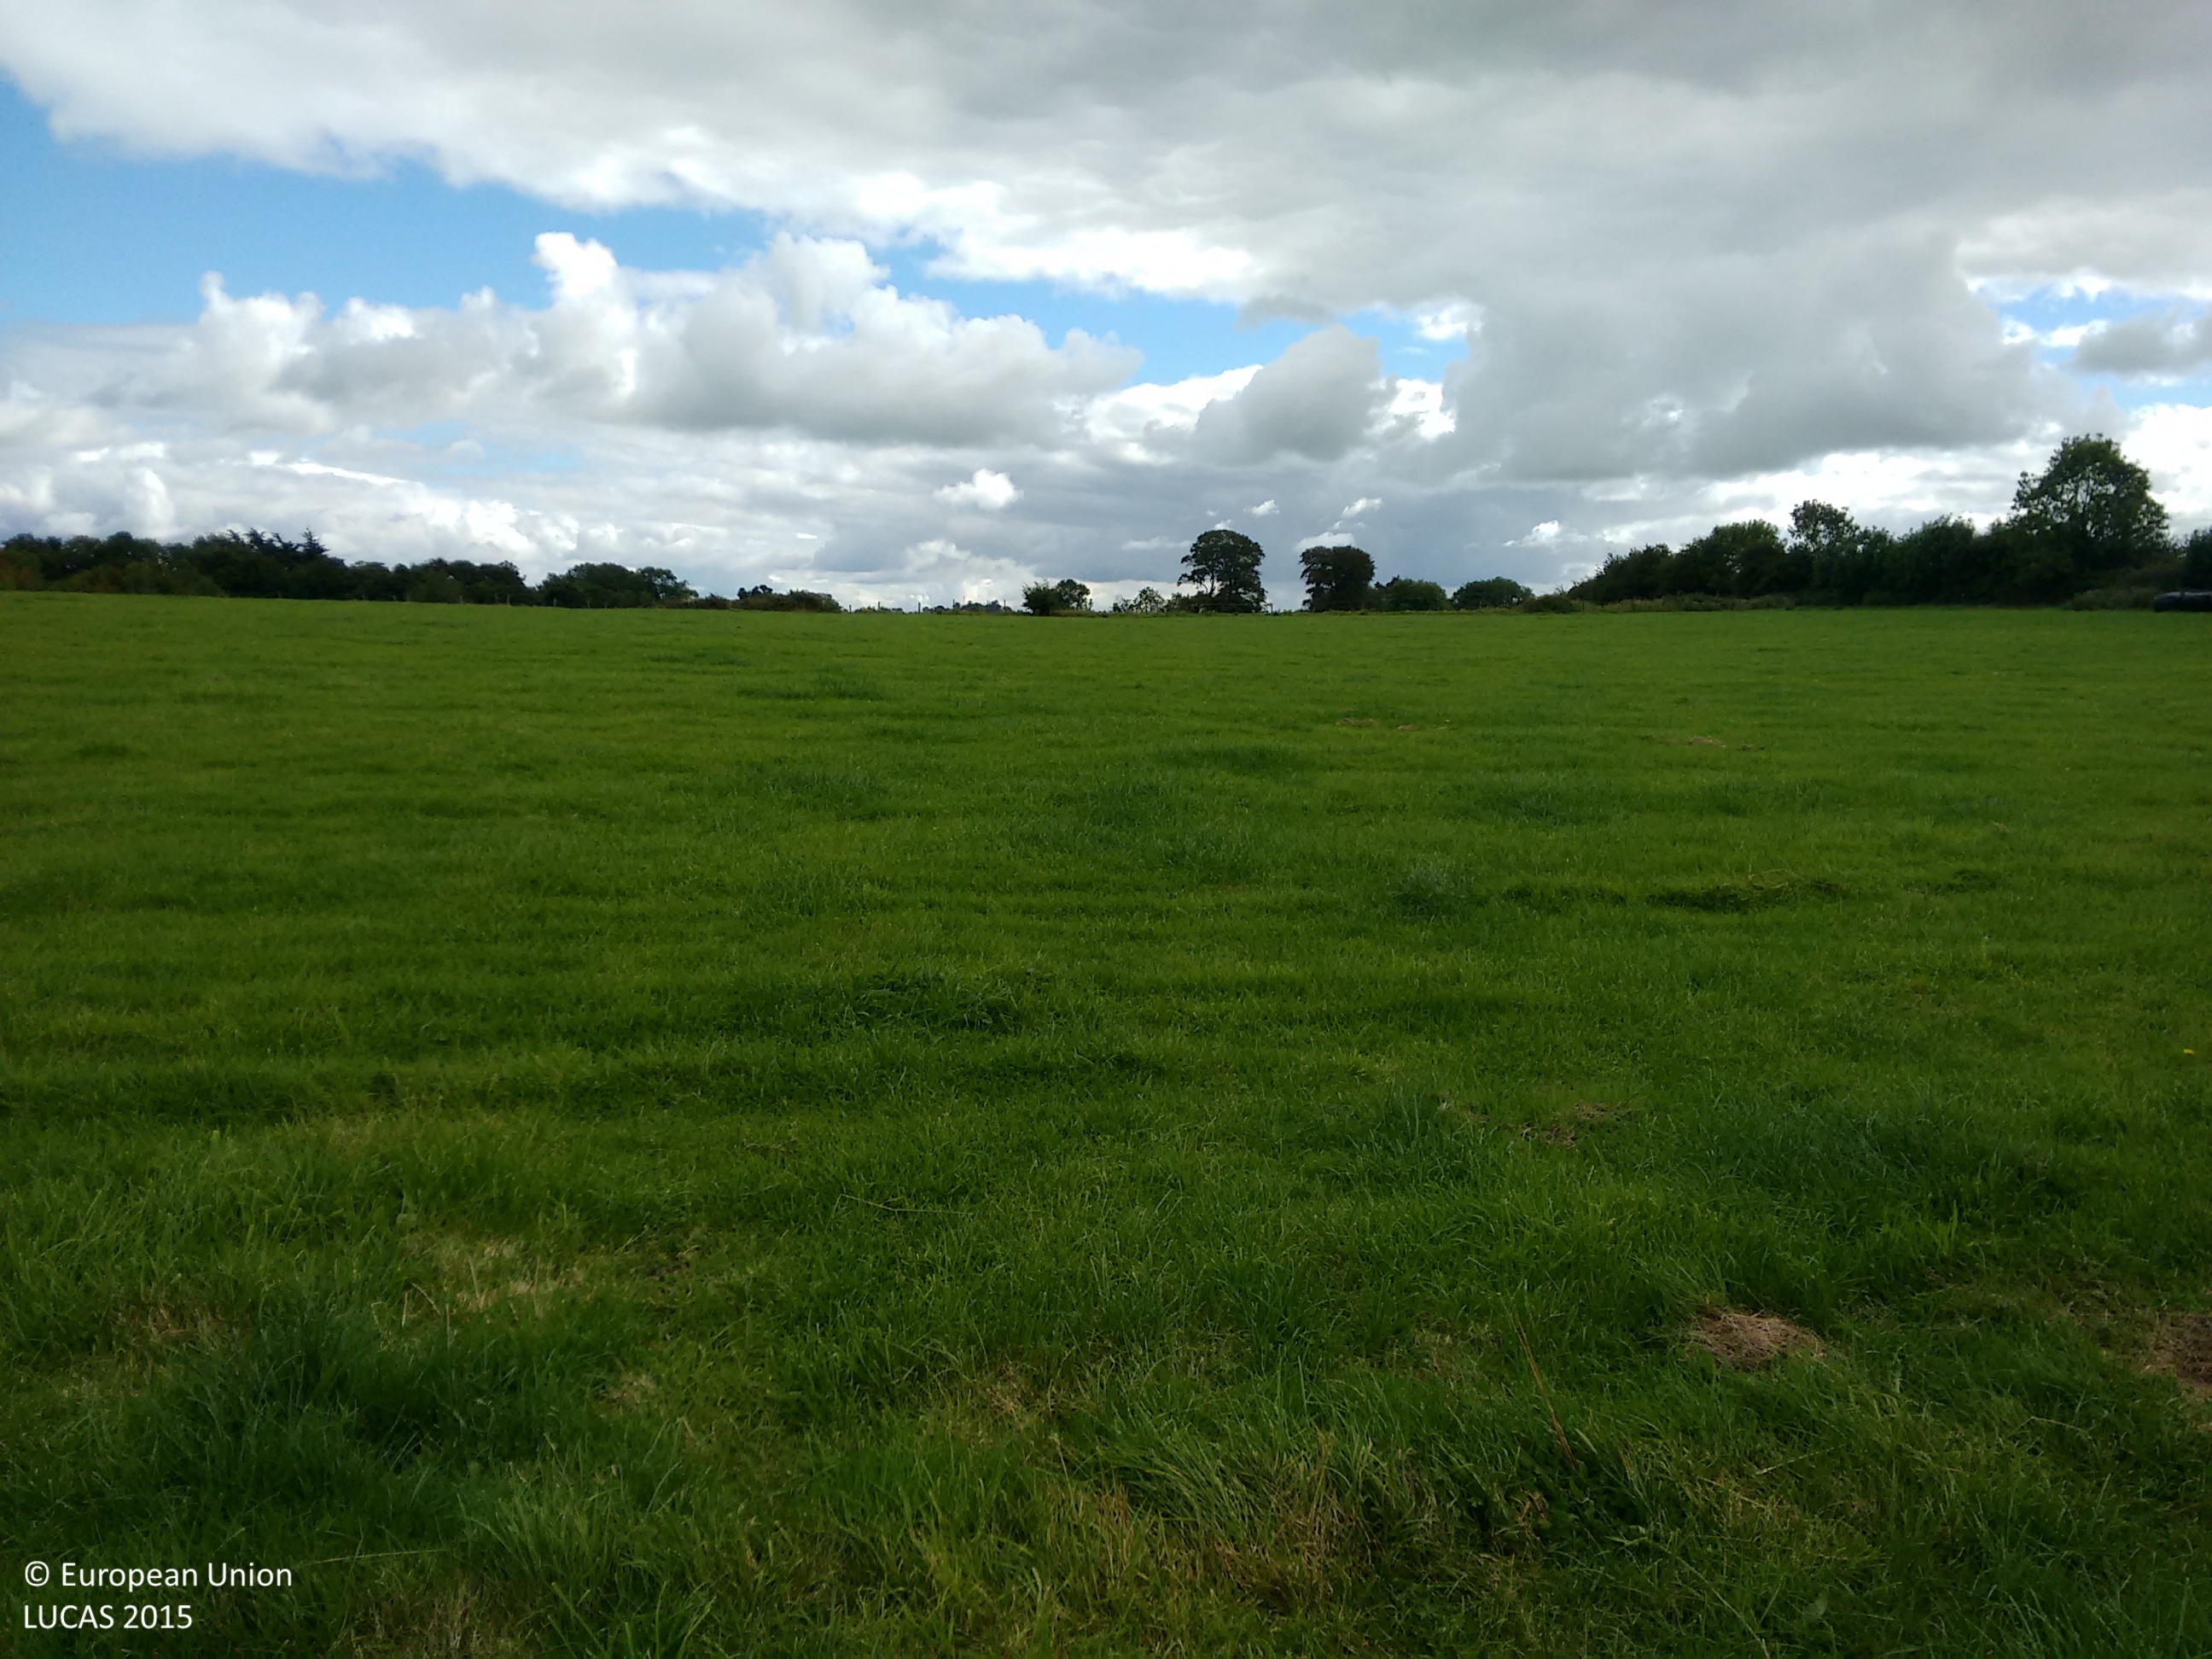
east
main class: Grassland
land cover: Grassland without tree/shrub cover
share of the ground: > 75 %
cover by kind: herbaceous plants 100 %
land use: Agriculture (excluding fallow land and kitchen gardens)
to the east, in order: Grassland without tree/shrub cover; Fences; Grass margins; Fences; Grass margins; Fences; Grassland without tree/shrub cover
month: September
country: IE
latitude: 52.5404
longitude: -8.5526
